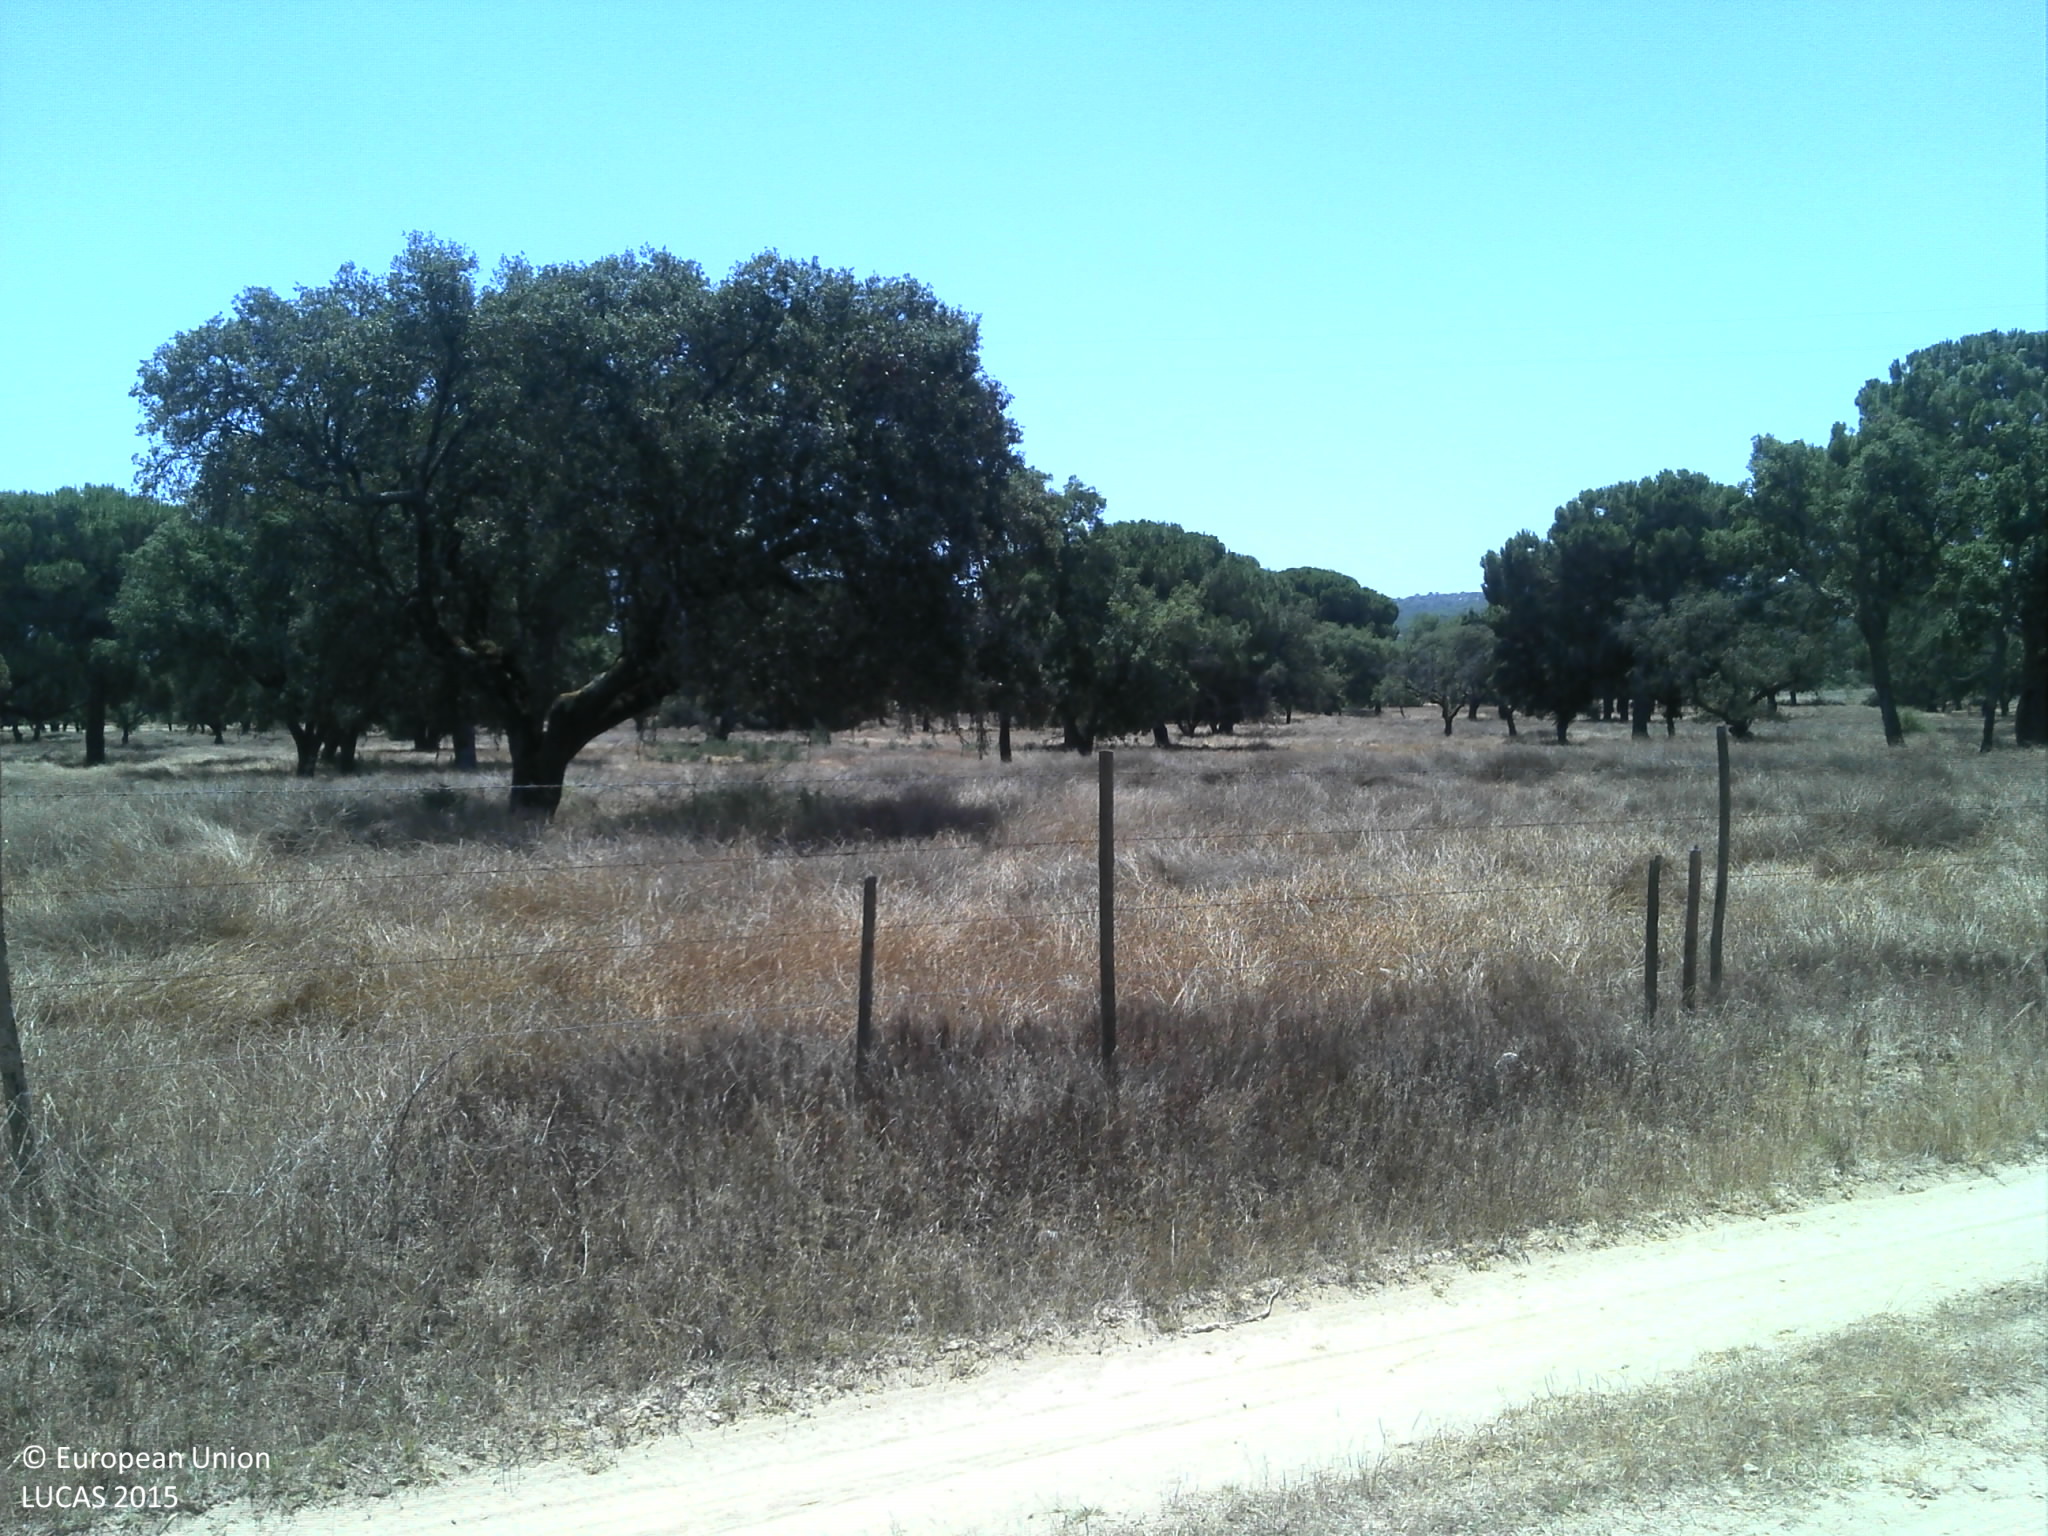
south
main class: Grassland
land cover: Spontaneously vegetated surfaces
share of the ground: 50 - 75 %
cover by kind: herbaceous plants 90 %, unconsolidated bare surface 10 %
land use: Fallow land
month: July
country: PT
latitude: 38.9985
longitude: -8.2654
